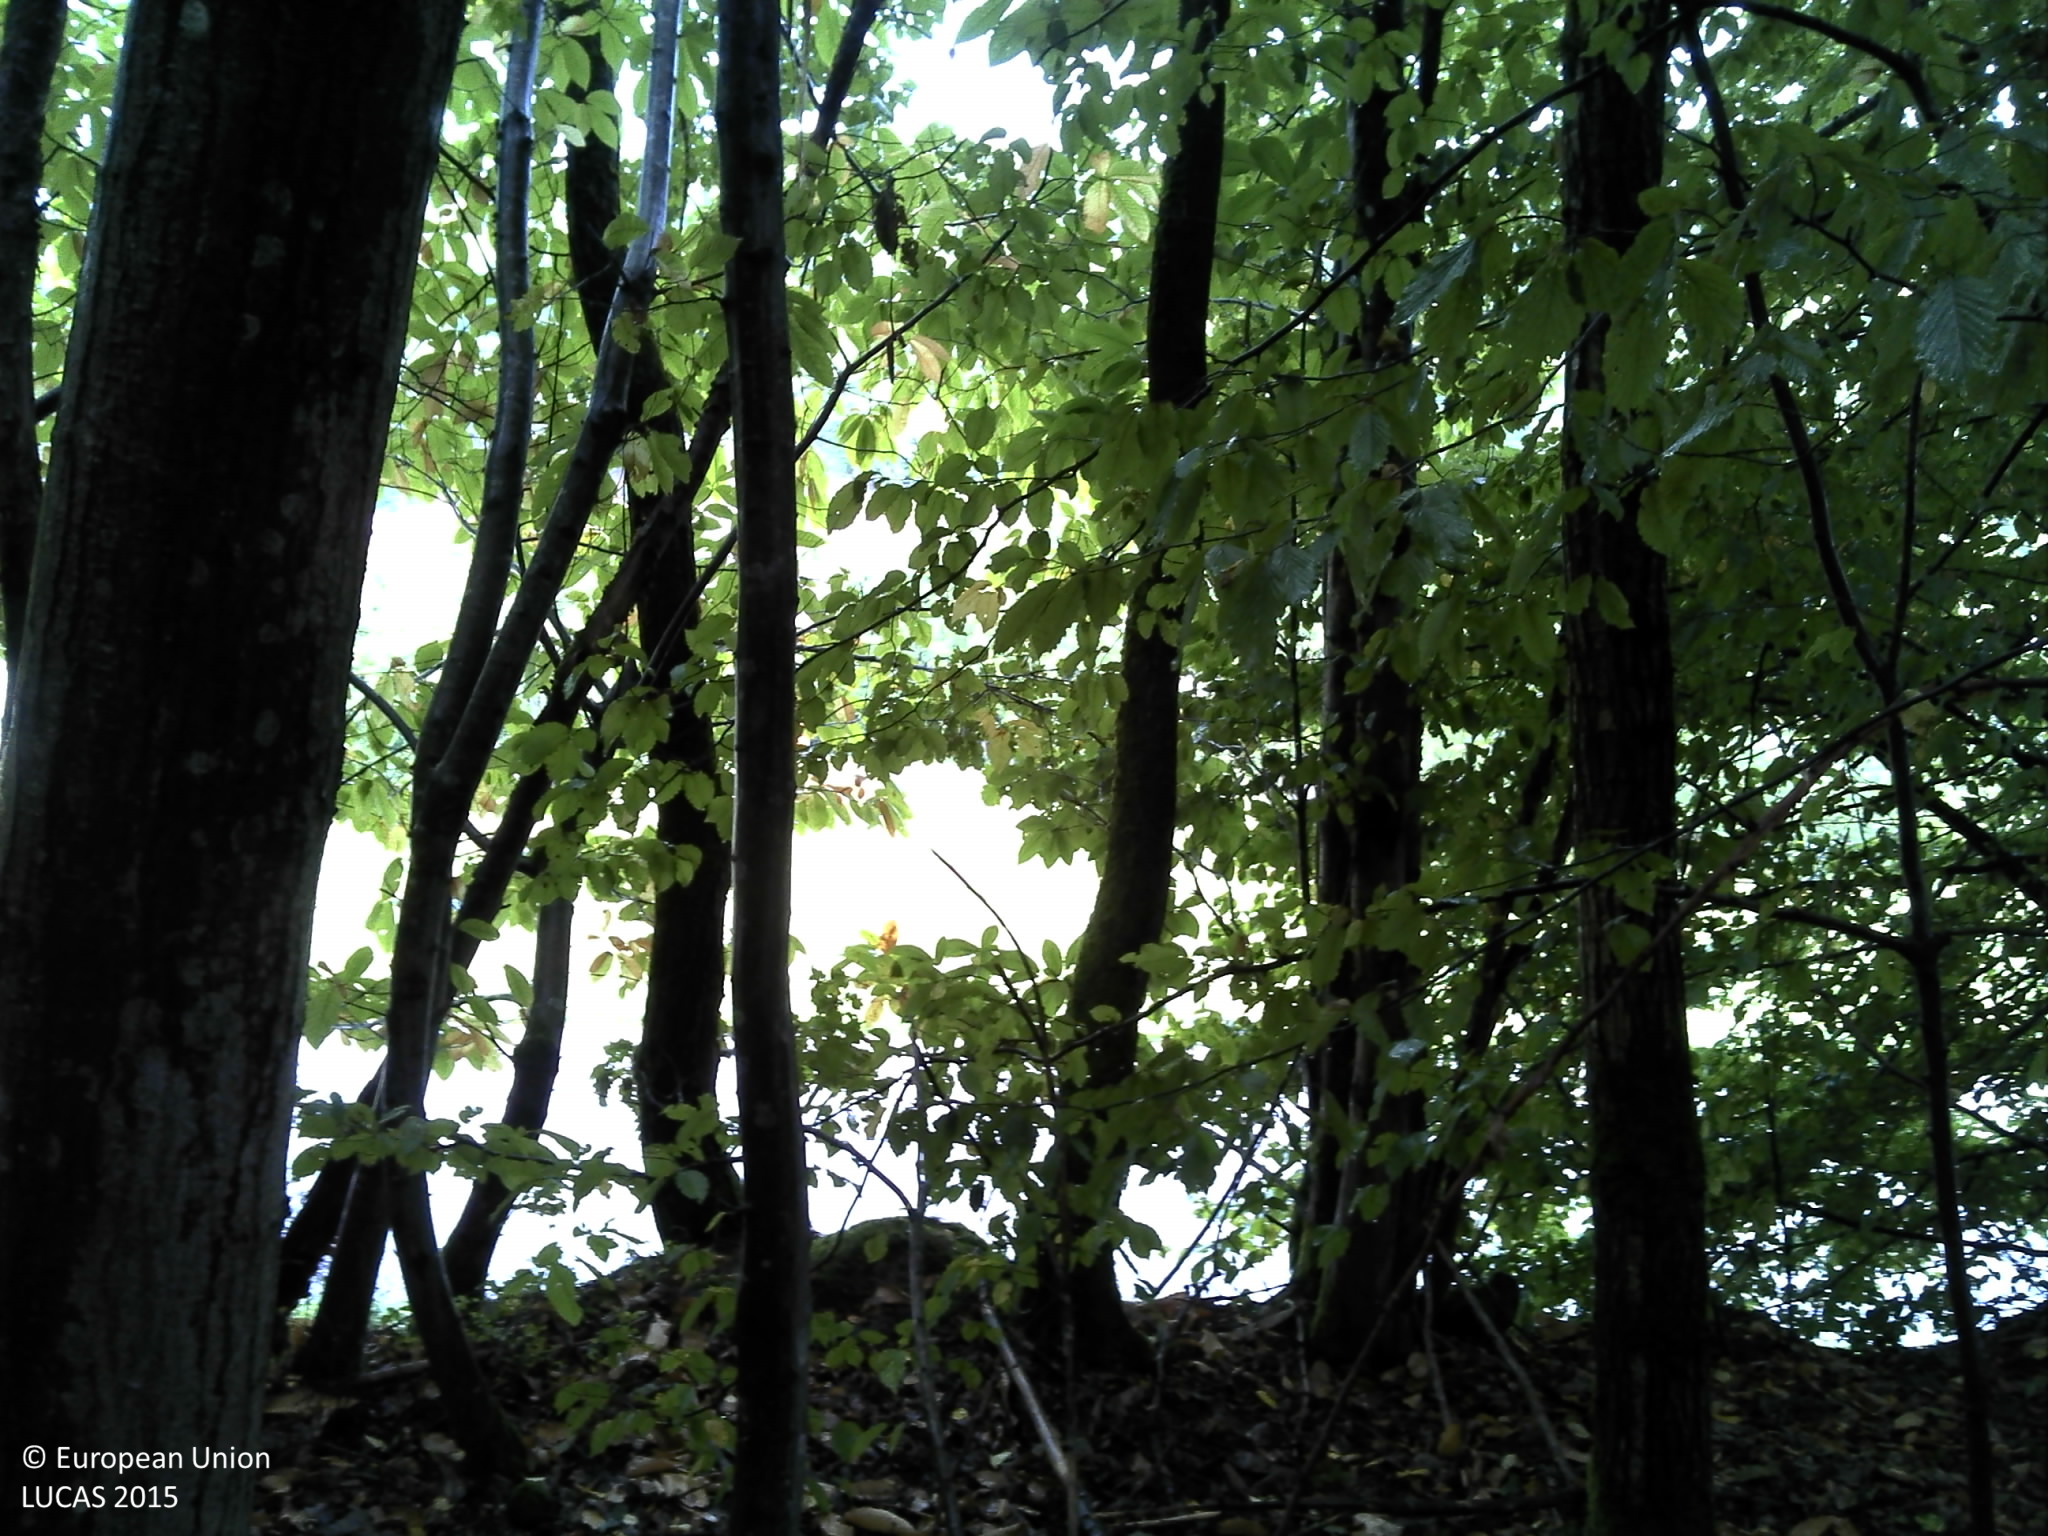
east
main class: Woodland
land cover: Broadleaved woodland
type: mesophytic deciduous forest
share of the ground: > 75 %
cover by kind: broadleaved forest trees 90 %, consolidated bare surface 10 %
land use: Forestry
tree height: > 5 m
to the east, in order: Broadleaved woodland; Ditches and canals; Grass margins; Paved roads, cycling and walking lanes; Grassland without tree/shrub cover; Single bushes/trees; Grassland without tree/shrub cover; Electric lines; Grass margins; Paved roads, cycling and walking lanes; Grass margins; Fences; Spontaneously vegetated surfaces; Inland fresh running water; Broadleaved woodland; Artificial constructions in urban areas; Grassland without tree/shrub cover; Electric lines; Grassland without tree/shrub cover
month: September
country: FR
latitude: 48.3523
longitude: 7.2885
